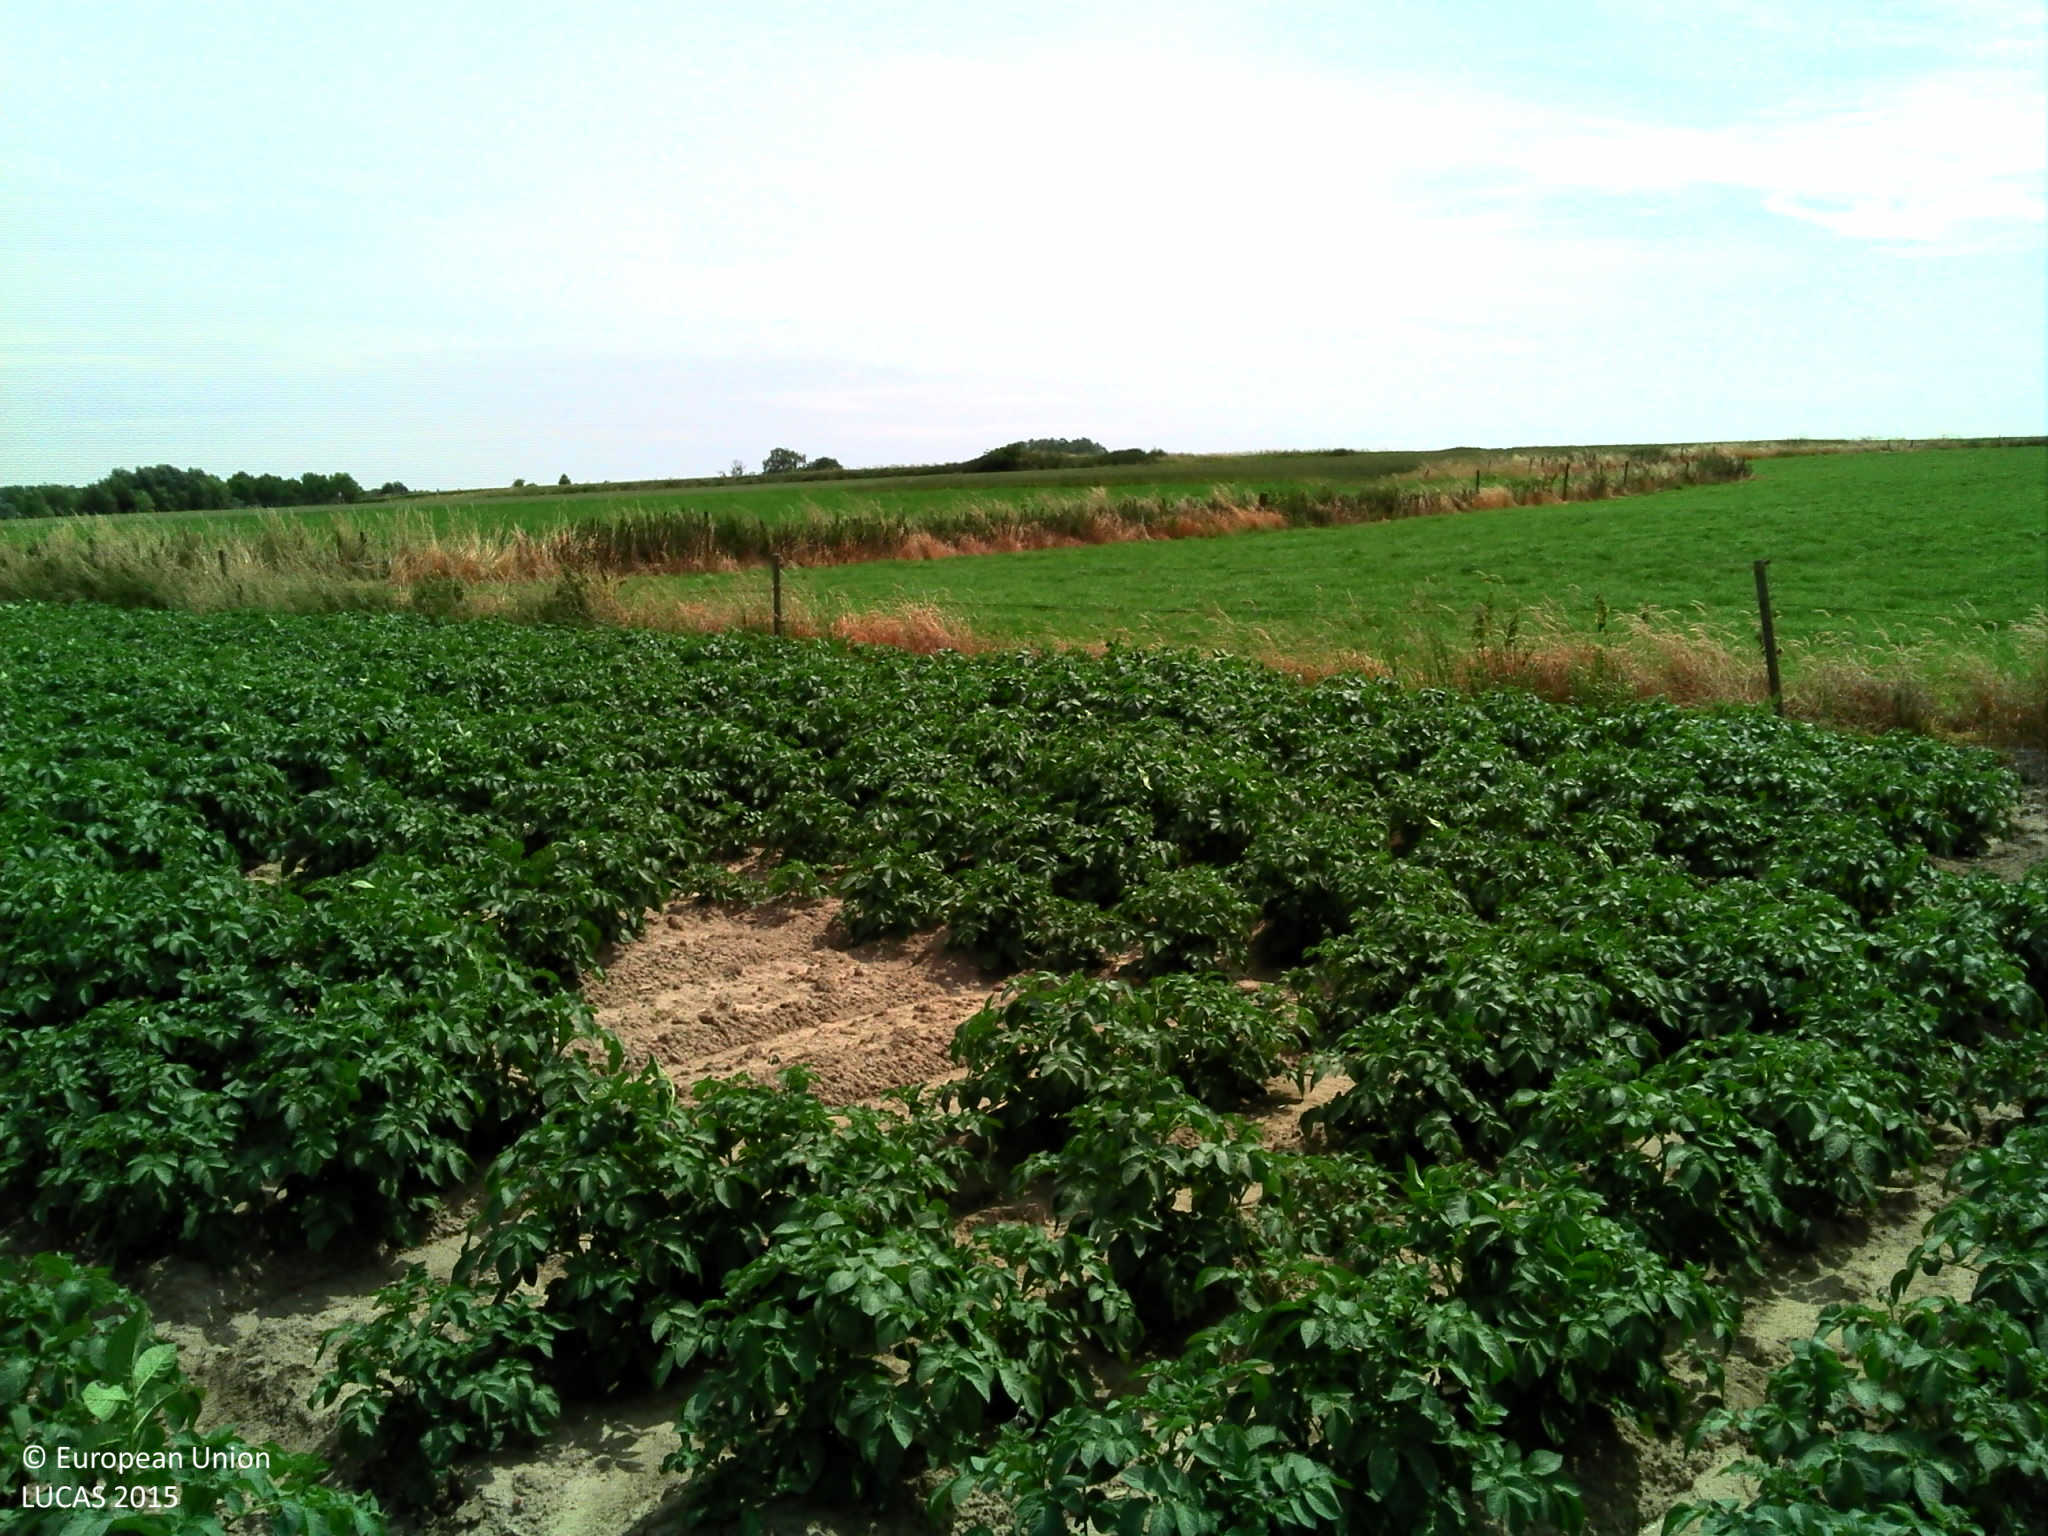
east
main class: Cropland
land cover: Potatoes
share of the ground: 50 - 75 %
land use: Agriculture (excluding fallow land and kitchen gardens)
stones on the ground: < 10 %
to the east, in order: Potatoes; Grass margins; Fences; Grassland without tree/shrub cover; Fences; Grass margins; Clovers; Common wheat; Clovers; Spontaneously vegetated surfaces; Common wheat; Grass margins; Ditches and canals; Grass margins; Paved roads, cycling and walking lanes
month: June
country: BE
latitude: 50.5487
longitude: 3.6562
